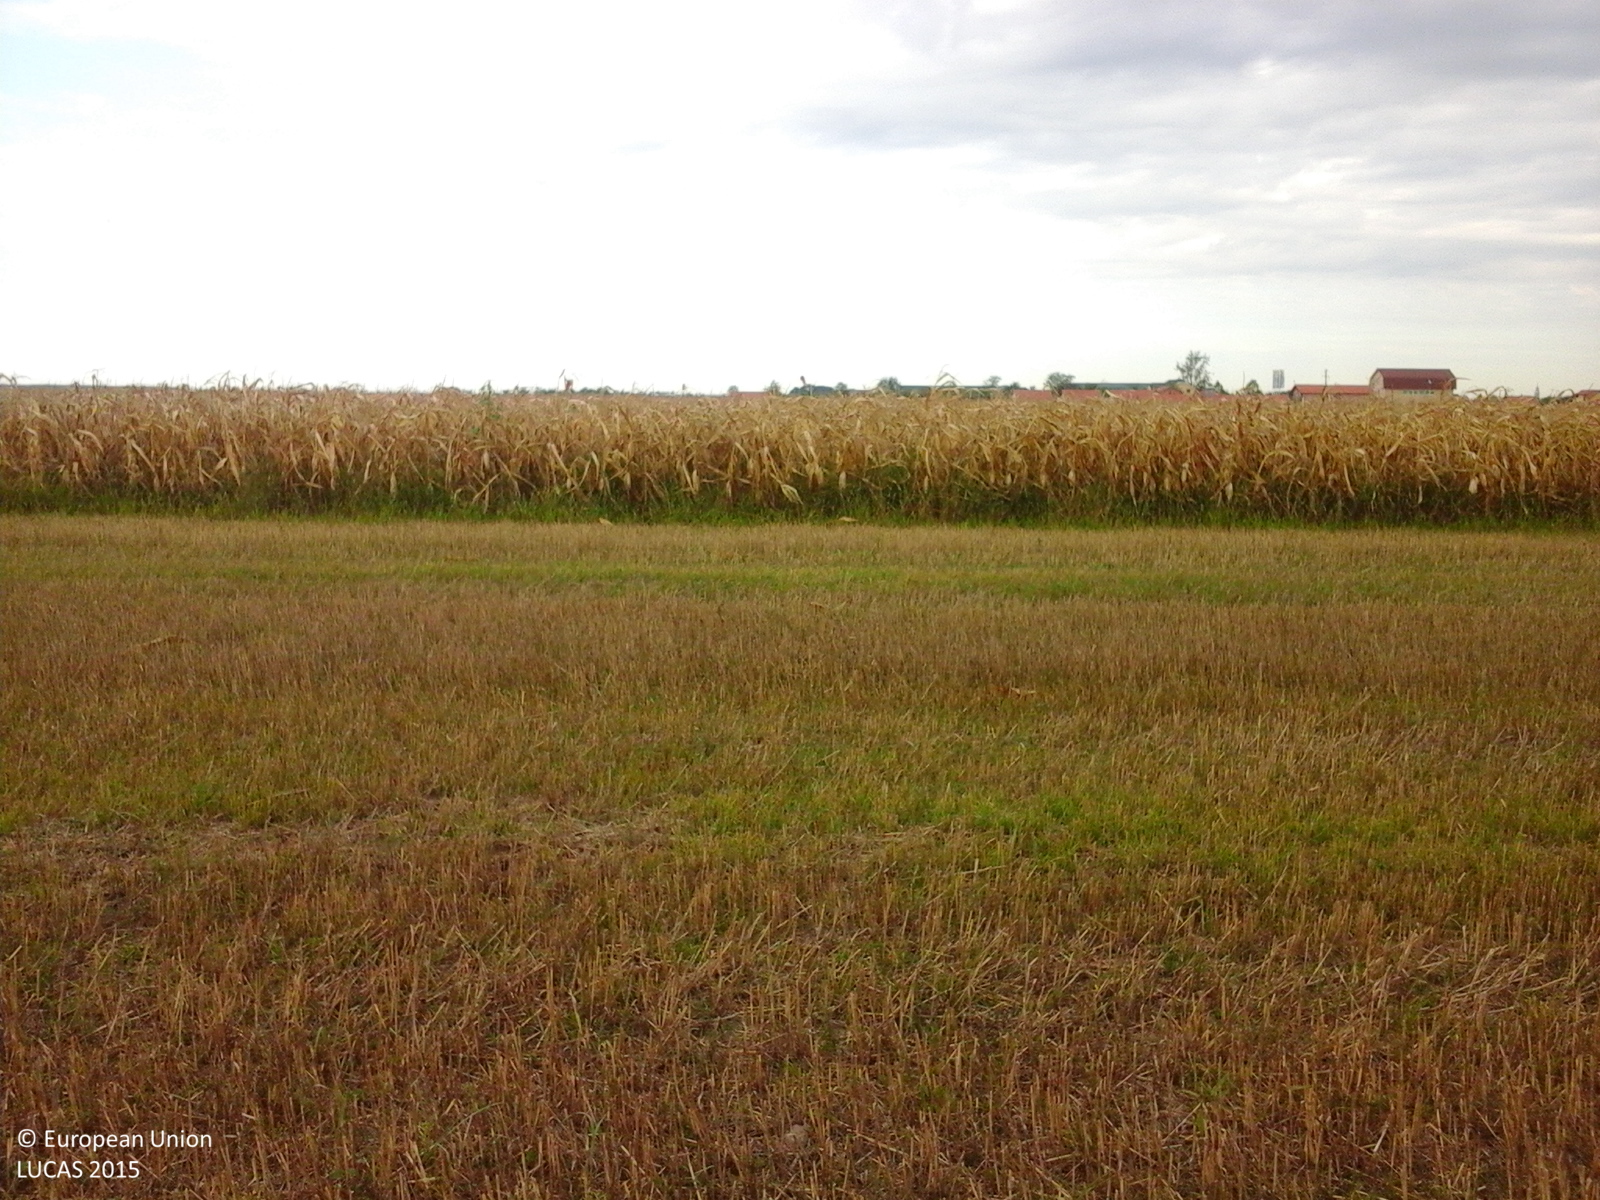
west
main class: Cropland
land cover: Common wheat
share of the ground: > 75 %
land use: Agriculture (excluding fallow land and kitchen gardens)
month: September
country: RO
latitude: 47.5523
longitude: 22.7516
